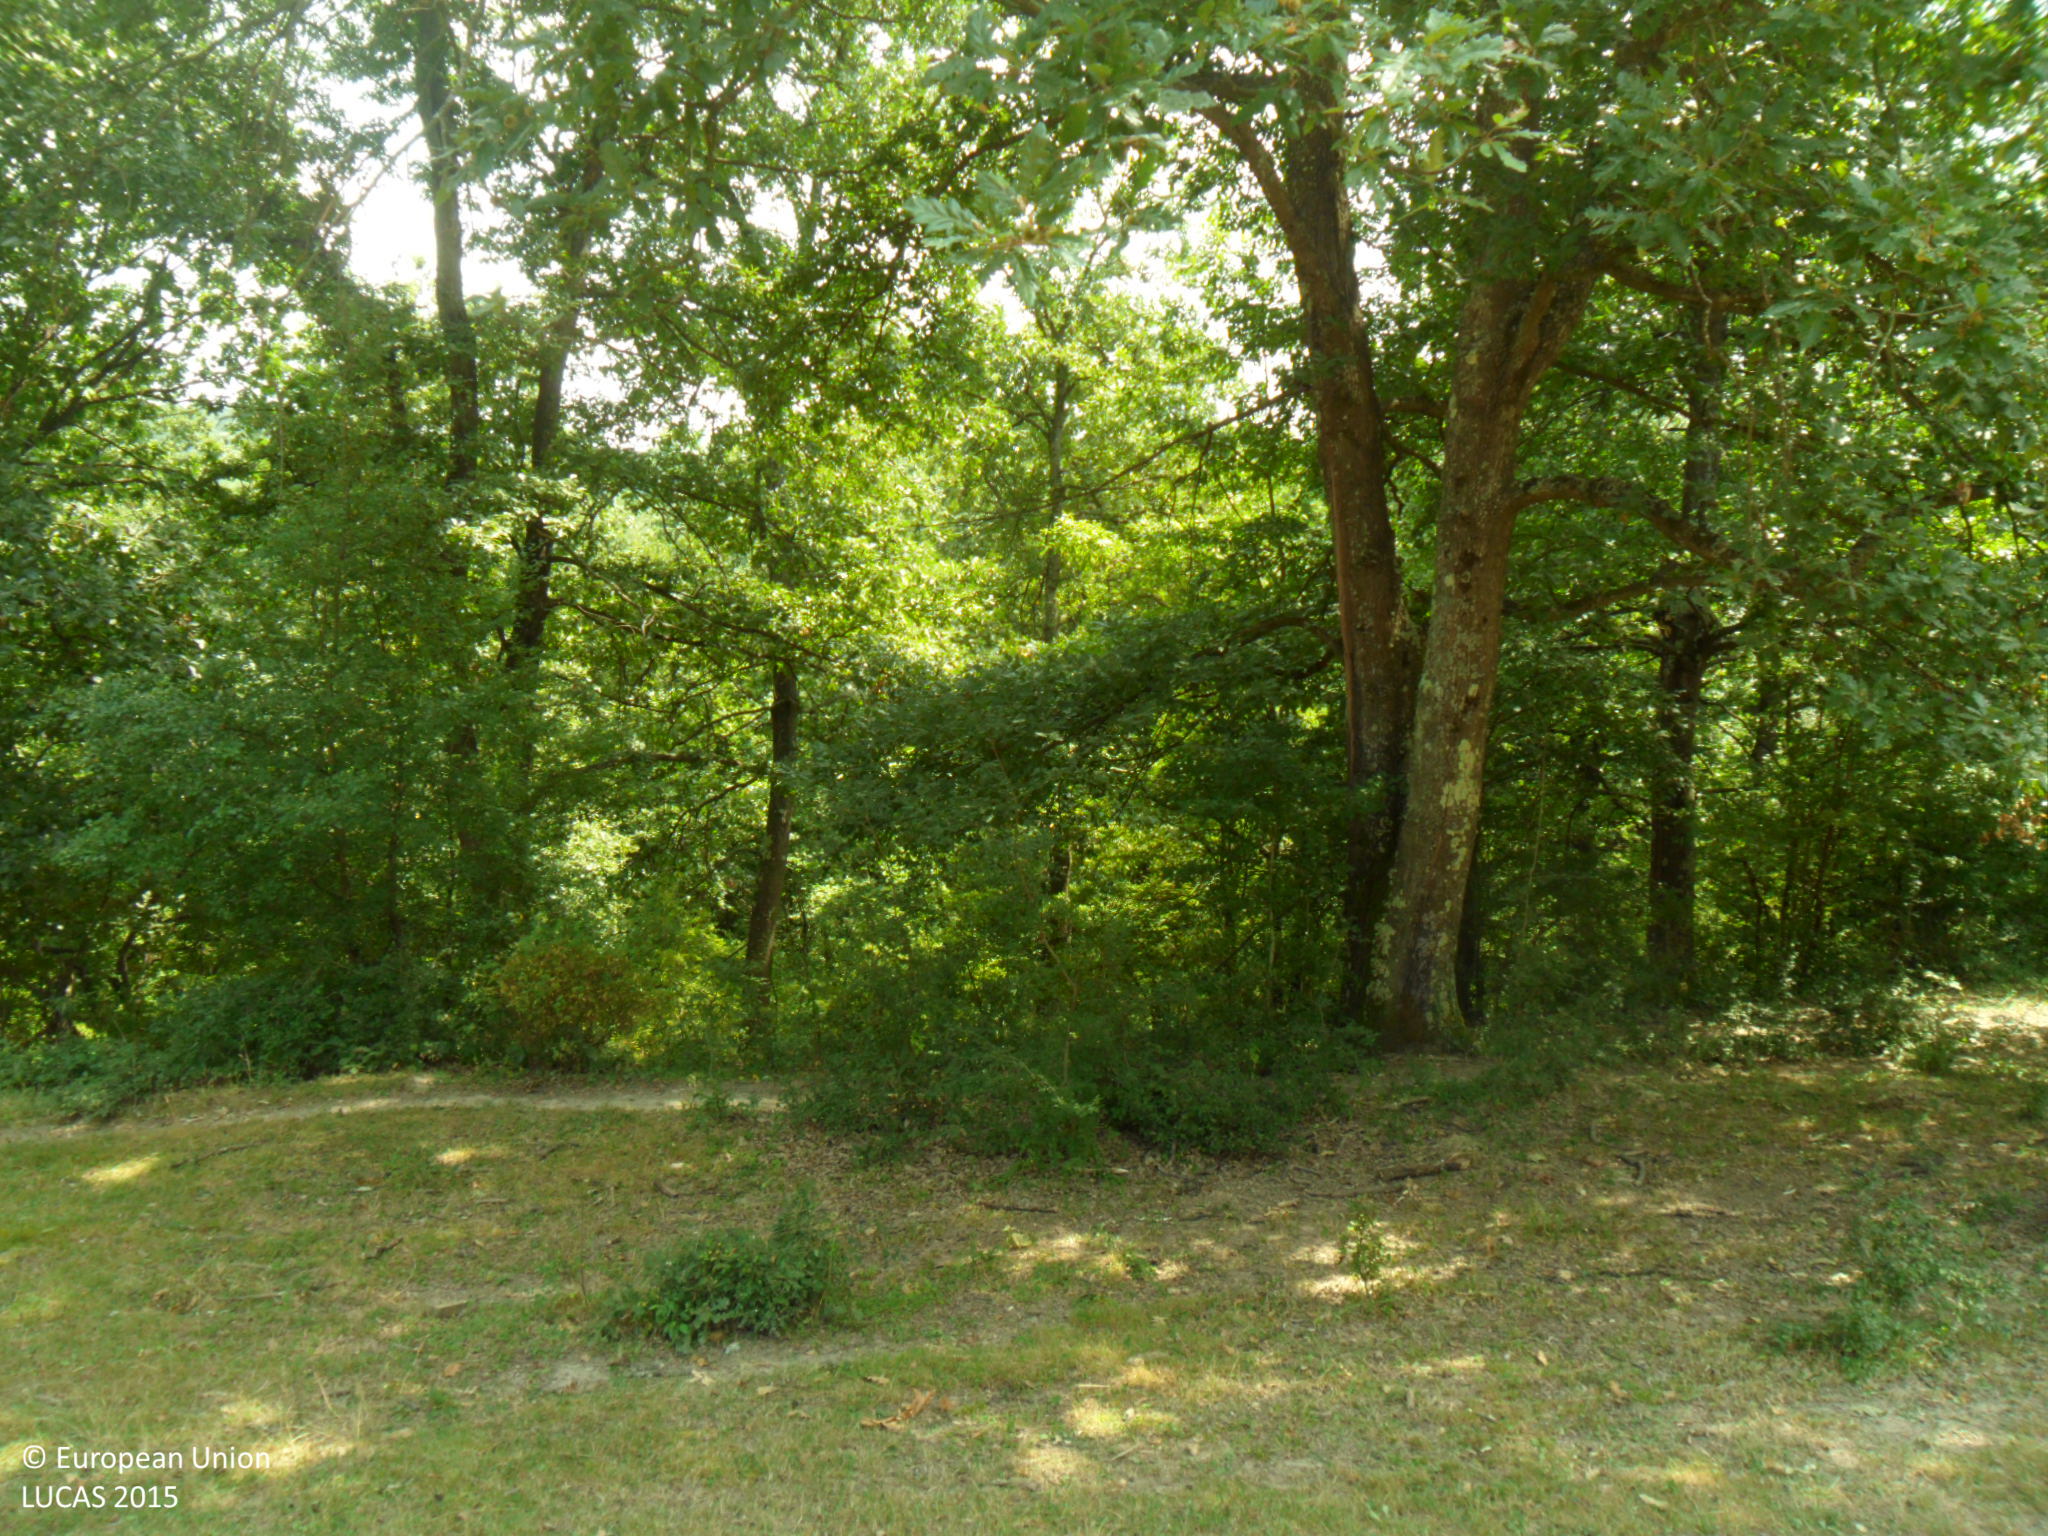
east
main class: Grassland
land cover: Grassland without tree/shrub cover
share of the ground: > 75 %
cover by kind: herbaceous plants 100 %
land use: Agriculture (excluding fallow land and kitchen gardens)
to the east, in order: Grassland without tree/shrub cover; Broadleaved woodland; Rivers and streams; Broadleaved woodland
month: August
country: BG
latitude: 43.0348
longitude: 26.7357
